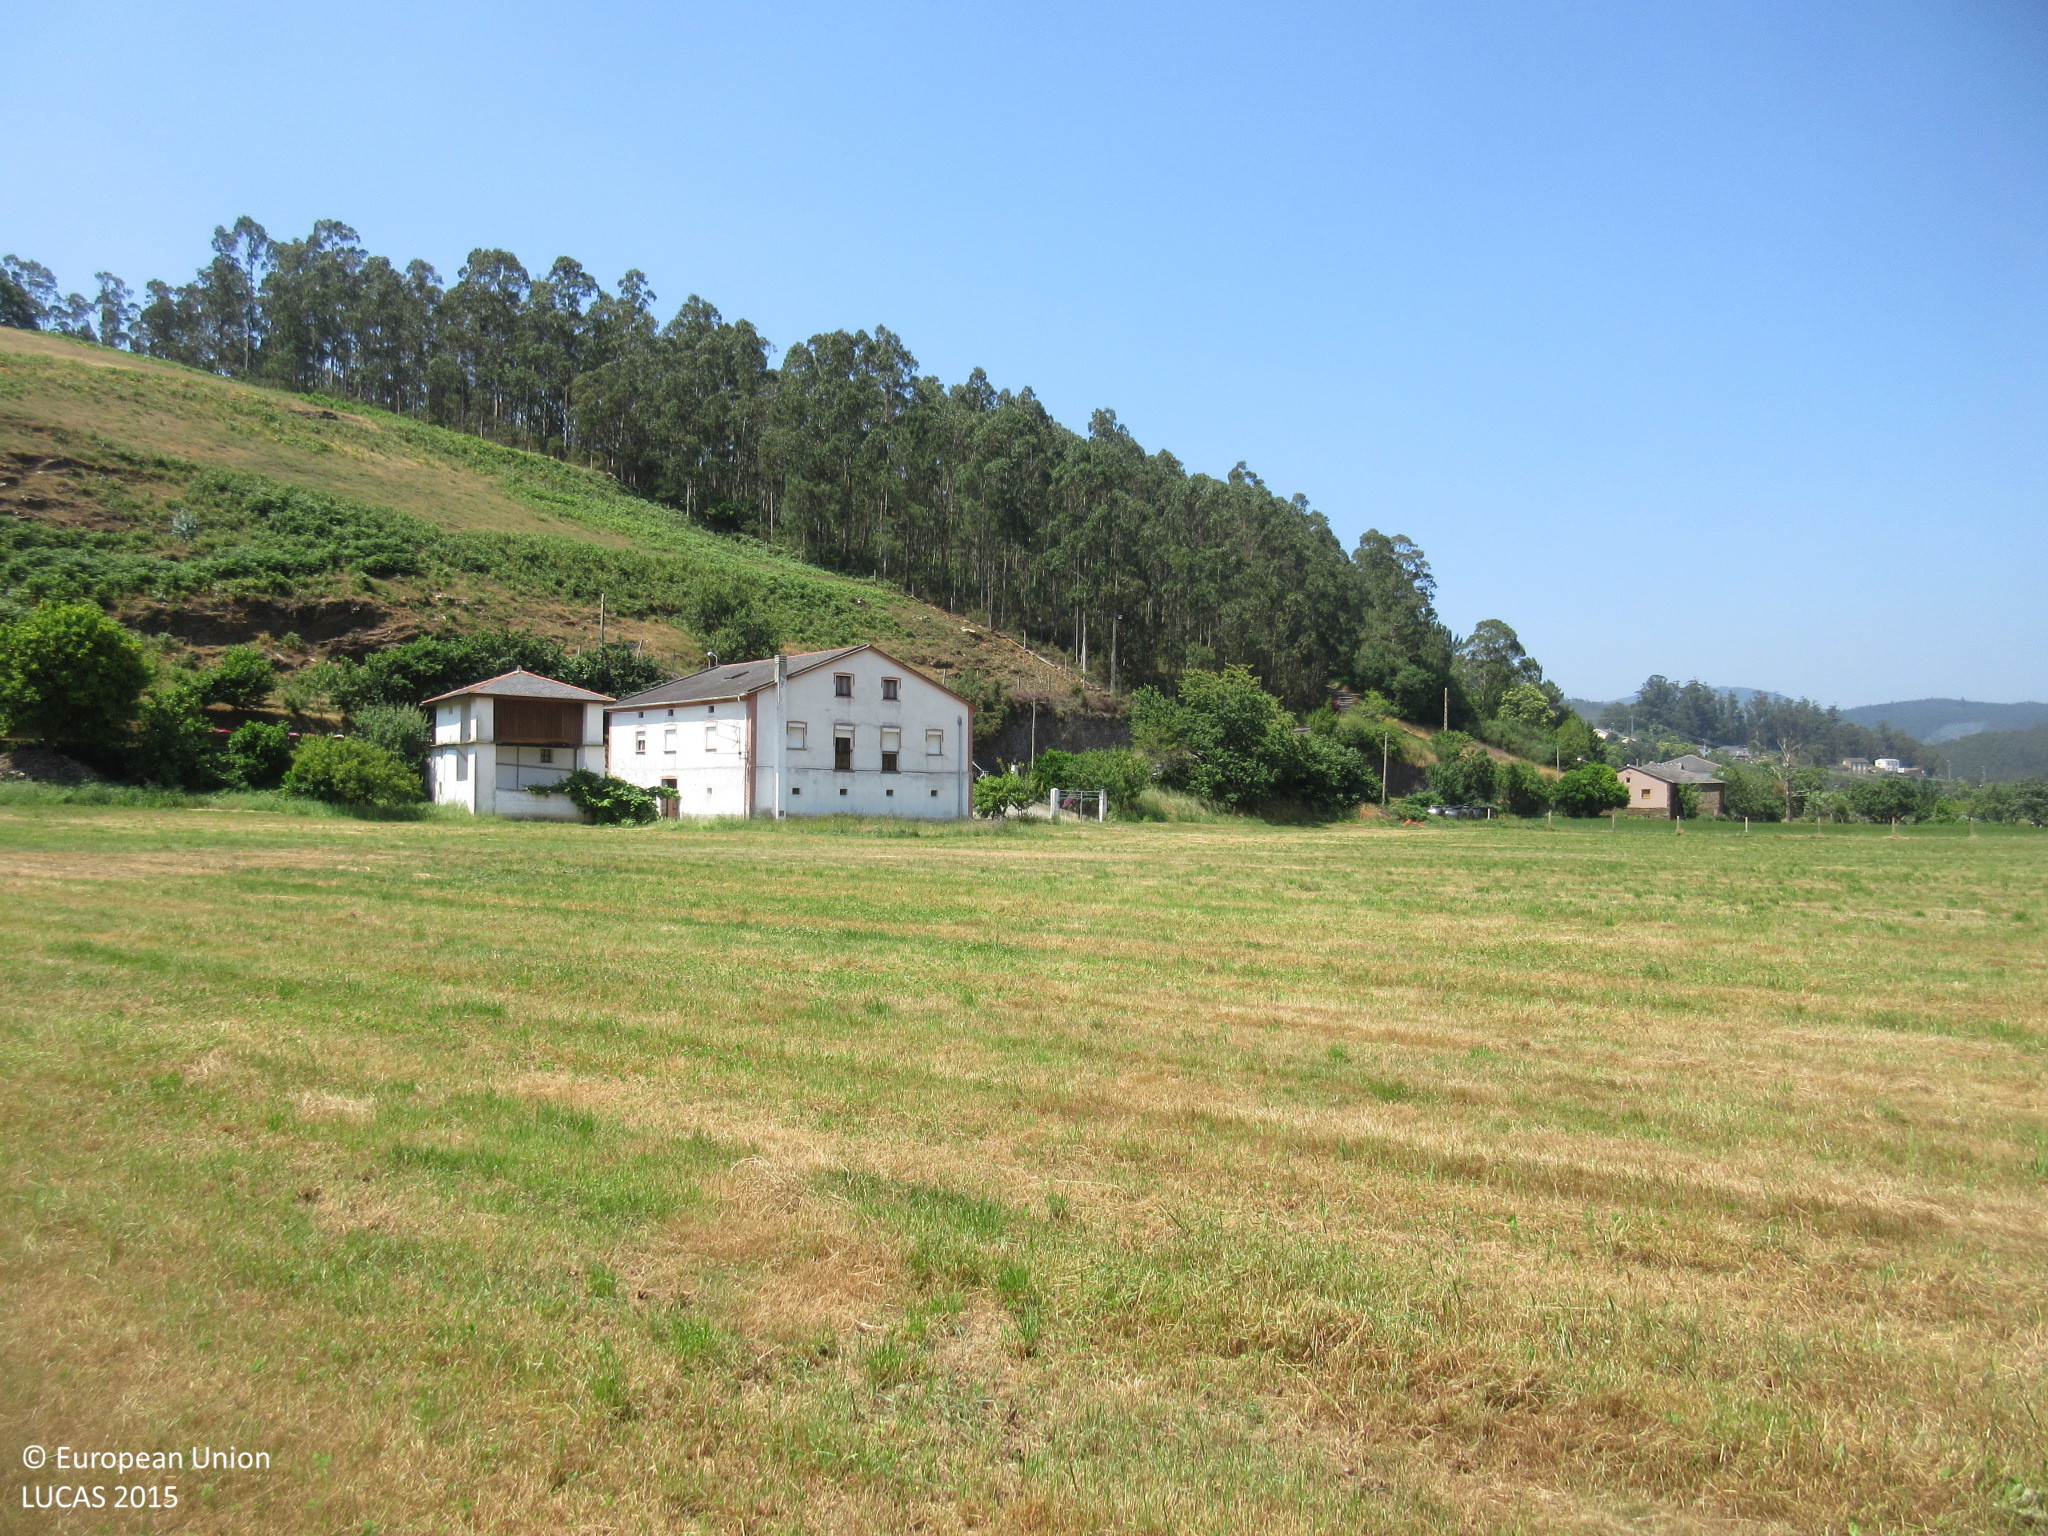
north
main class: Grassland
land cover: Grassland without tree/shrub cover
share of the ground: > 75 %
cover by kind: herbaceous plants 100 %
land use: Agriculture (excluding fallow land and kitchen gardens)
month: June
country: ES
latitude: 43.4069
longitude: -7.1488
